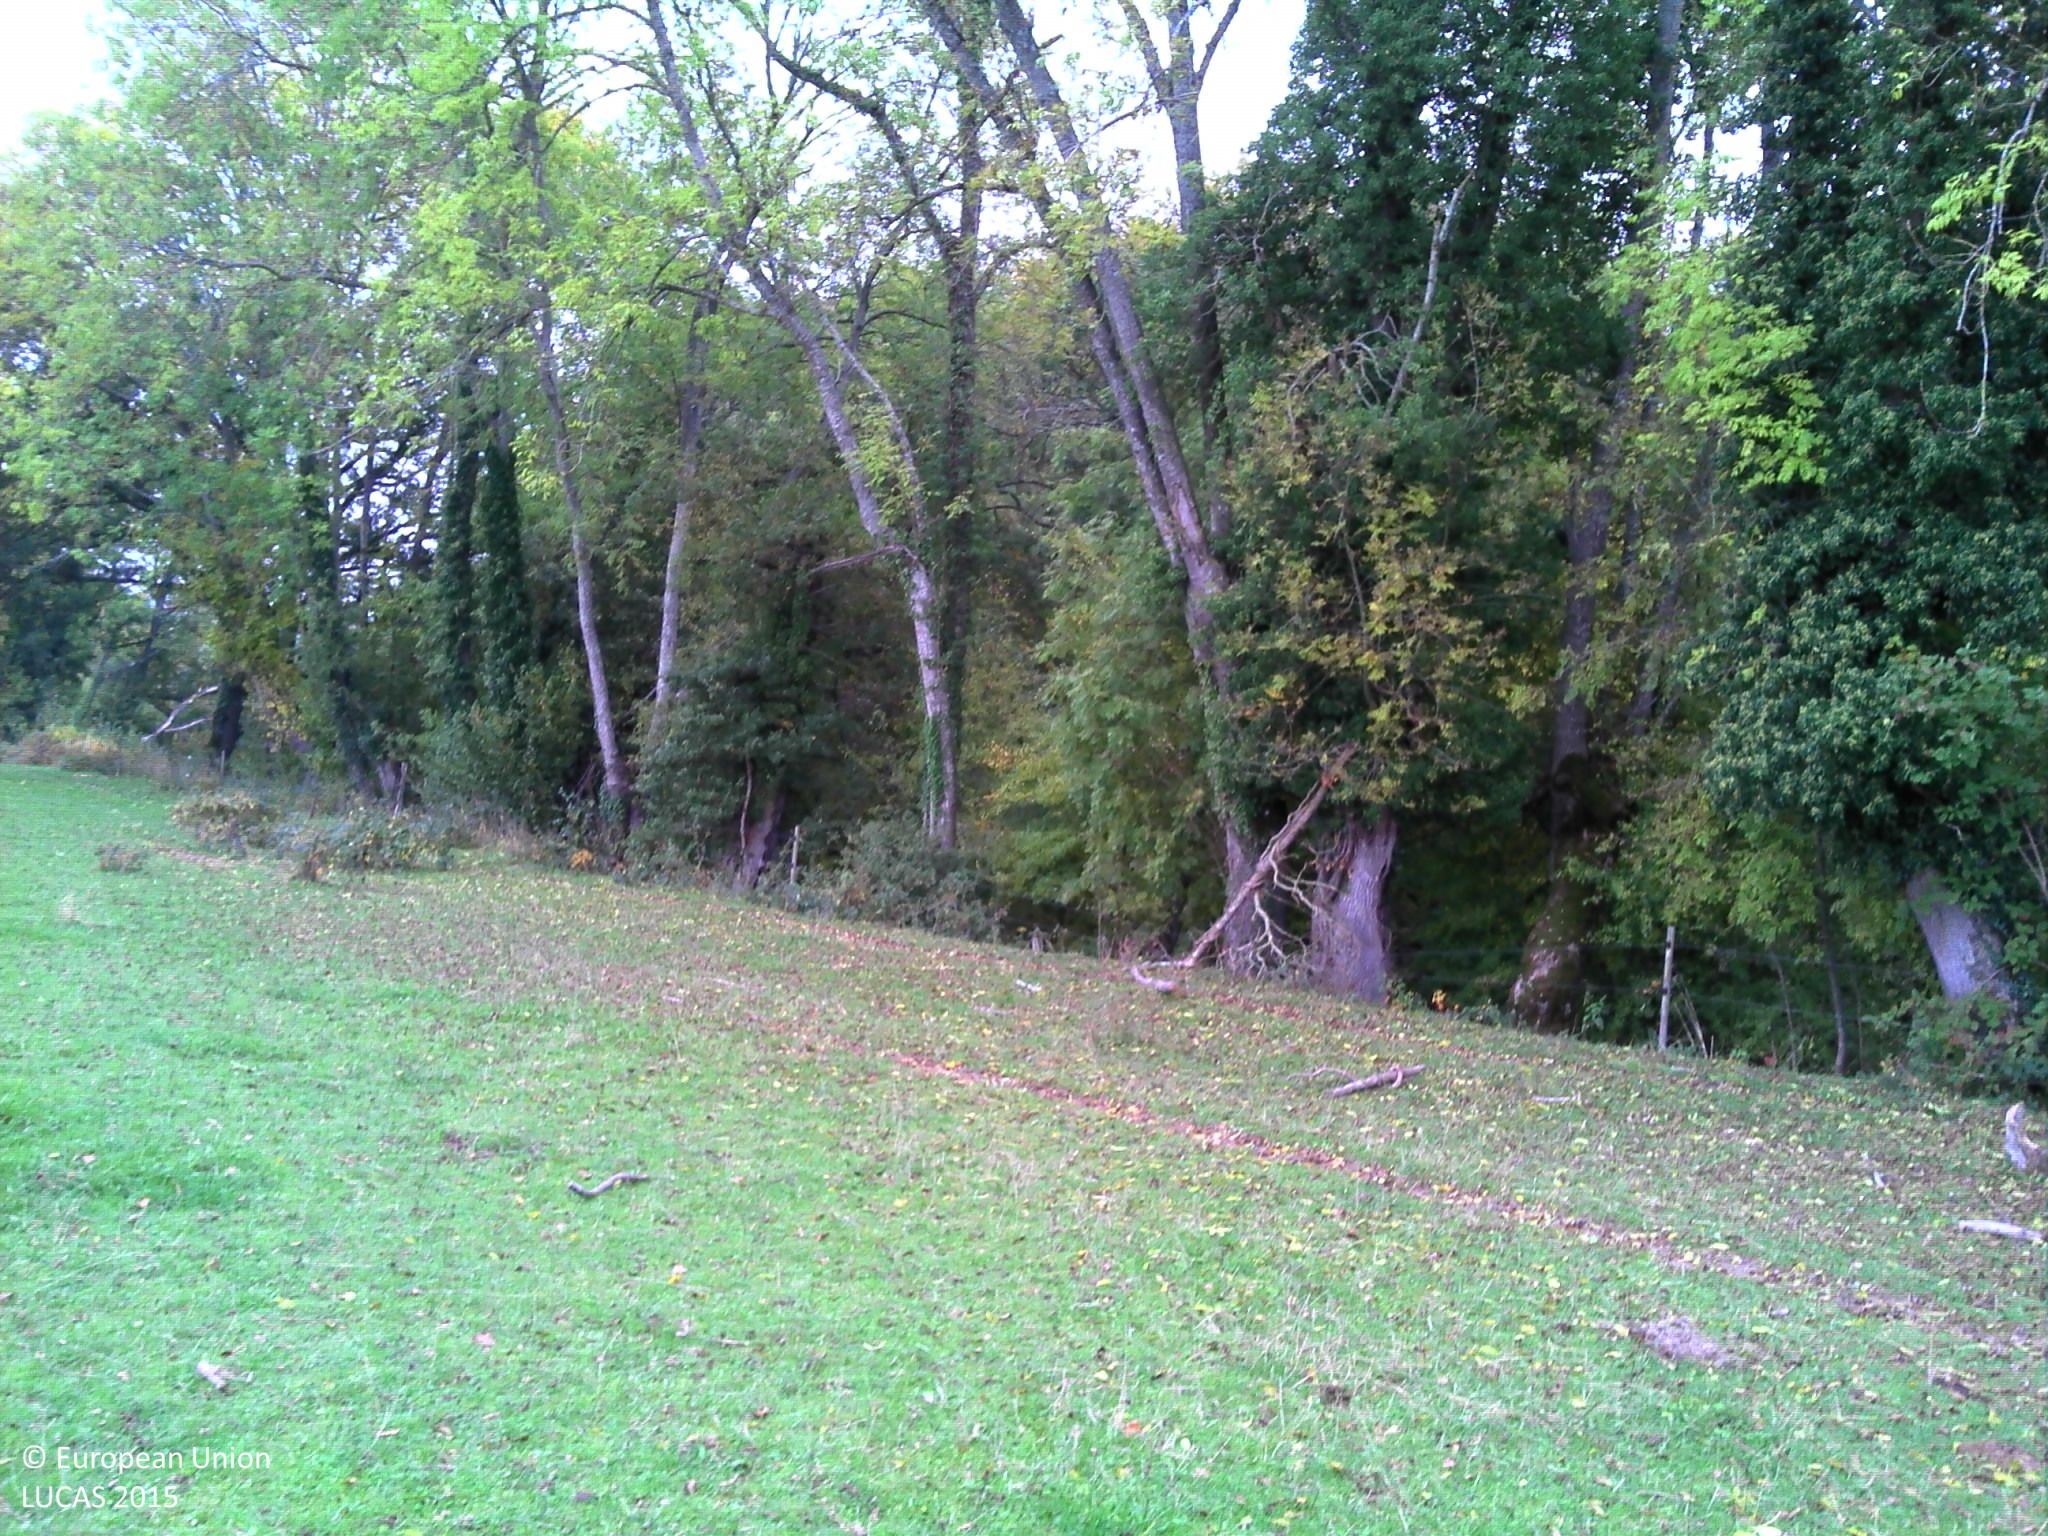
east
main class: Grassland
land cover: Grassland without tree/shrub cover
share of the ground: > 75 %
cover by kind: herbaceous plants 95 %, unconsolidated bare surface 5 %
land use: Agriculture (excluding fallow land and kitchen gardens)
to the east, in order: Grassland without tree/shrub cover; Fences; Broadleaved woodland; Rivers and streams; Broadleaved woodland; Shrubland without tree cover; Fences; Dry stone walls; Broadleaved woodland; Grassland without tree/shrub cover; Fences; Broadleaved woodland
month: October
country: FR
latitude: 45.9978
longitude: 3.0393
